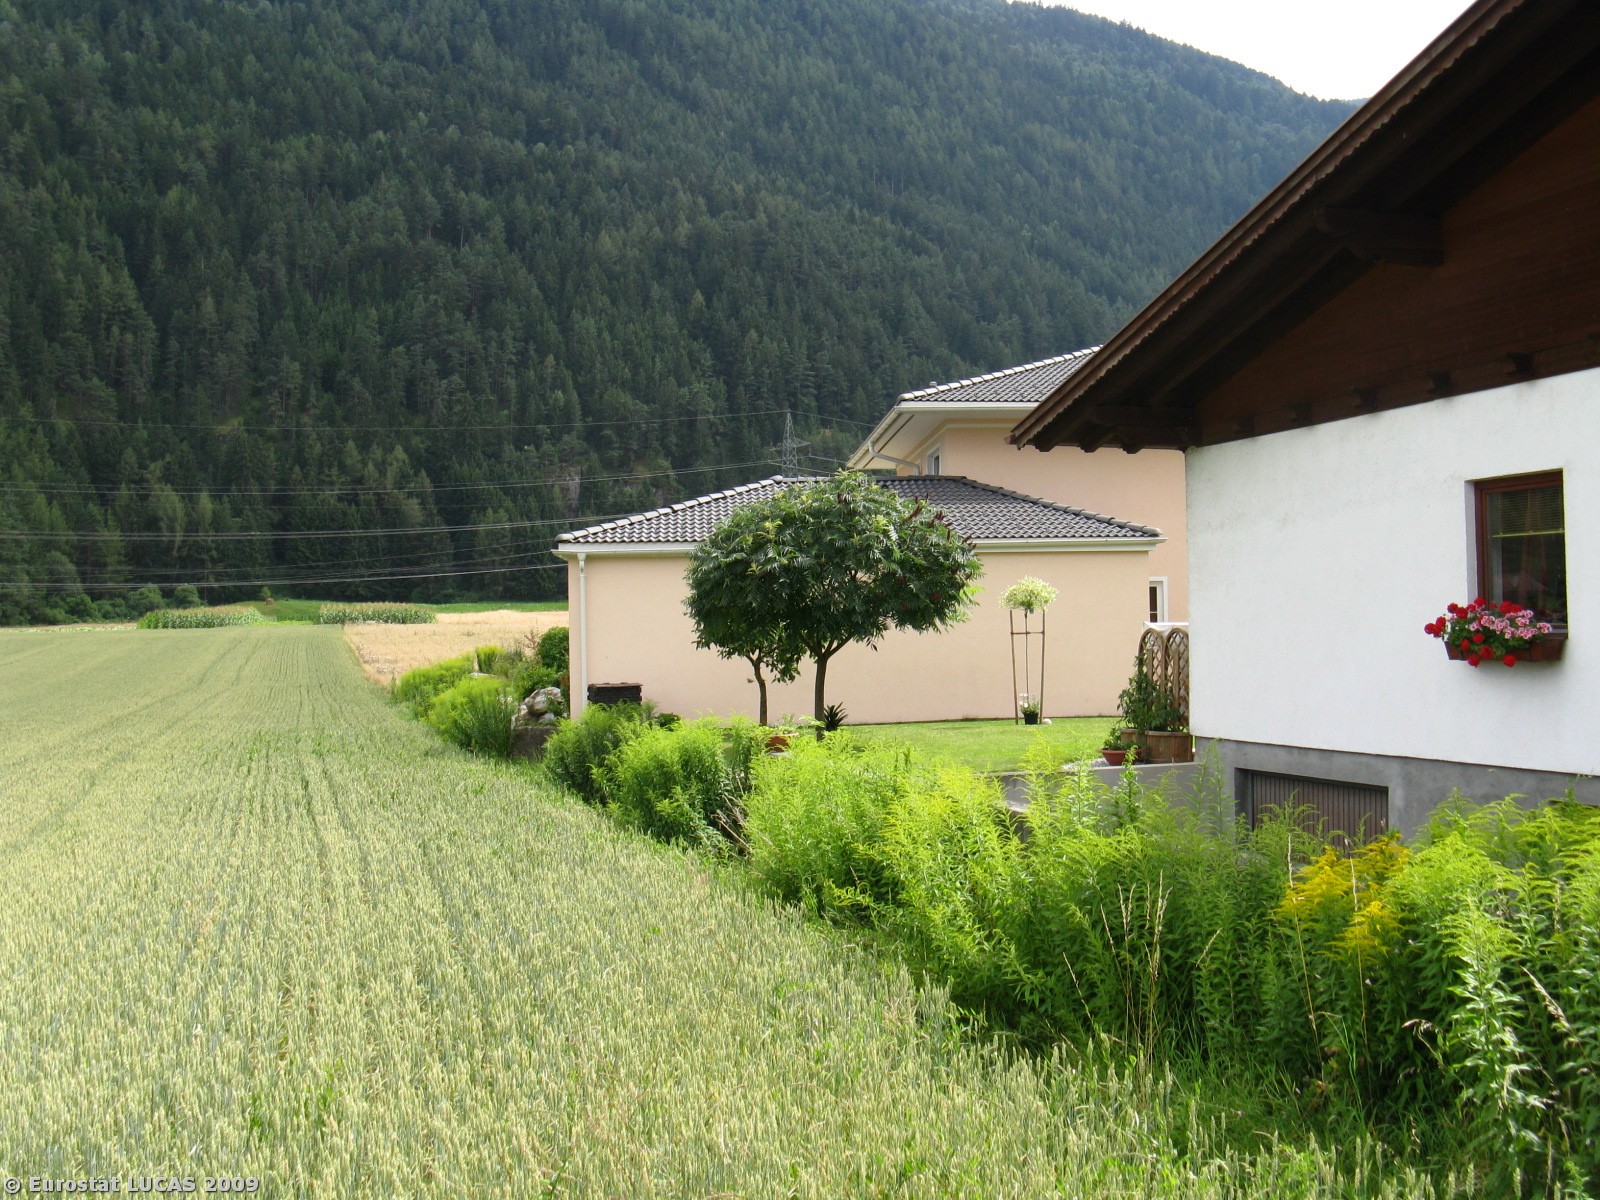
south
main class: Cropland
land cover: Common wheat
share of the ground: > 75 %
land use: Agriculture (excluding fallow land and kitchen gardens)
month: July
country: AT
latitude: 47.2655
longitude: 10.9375
